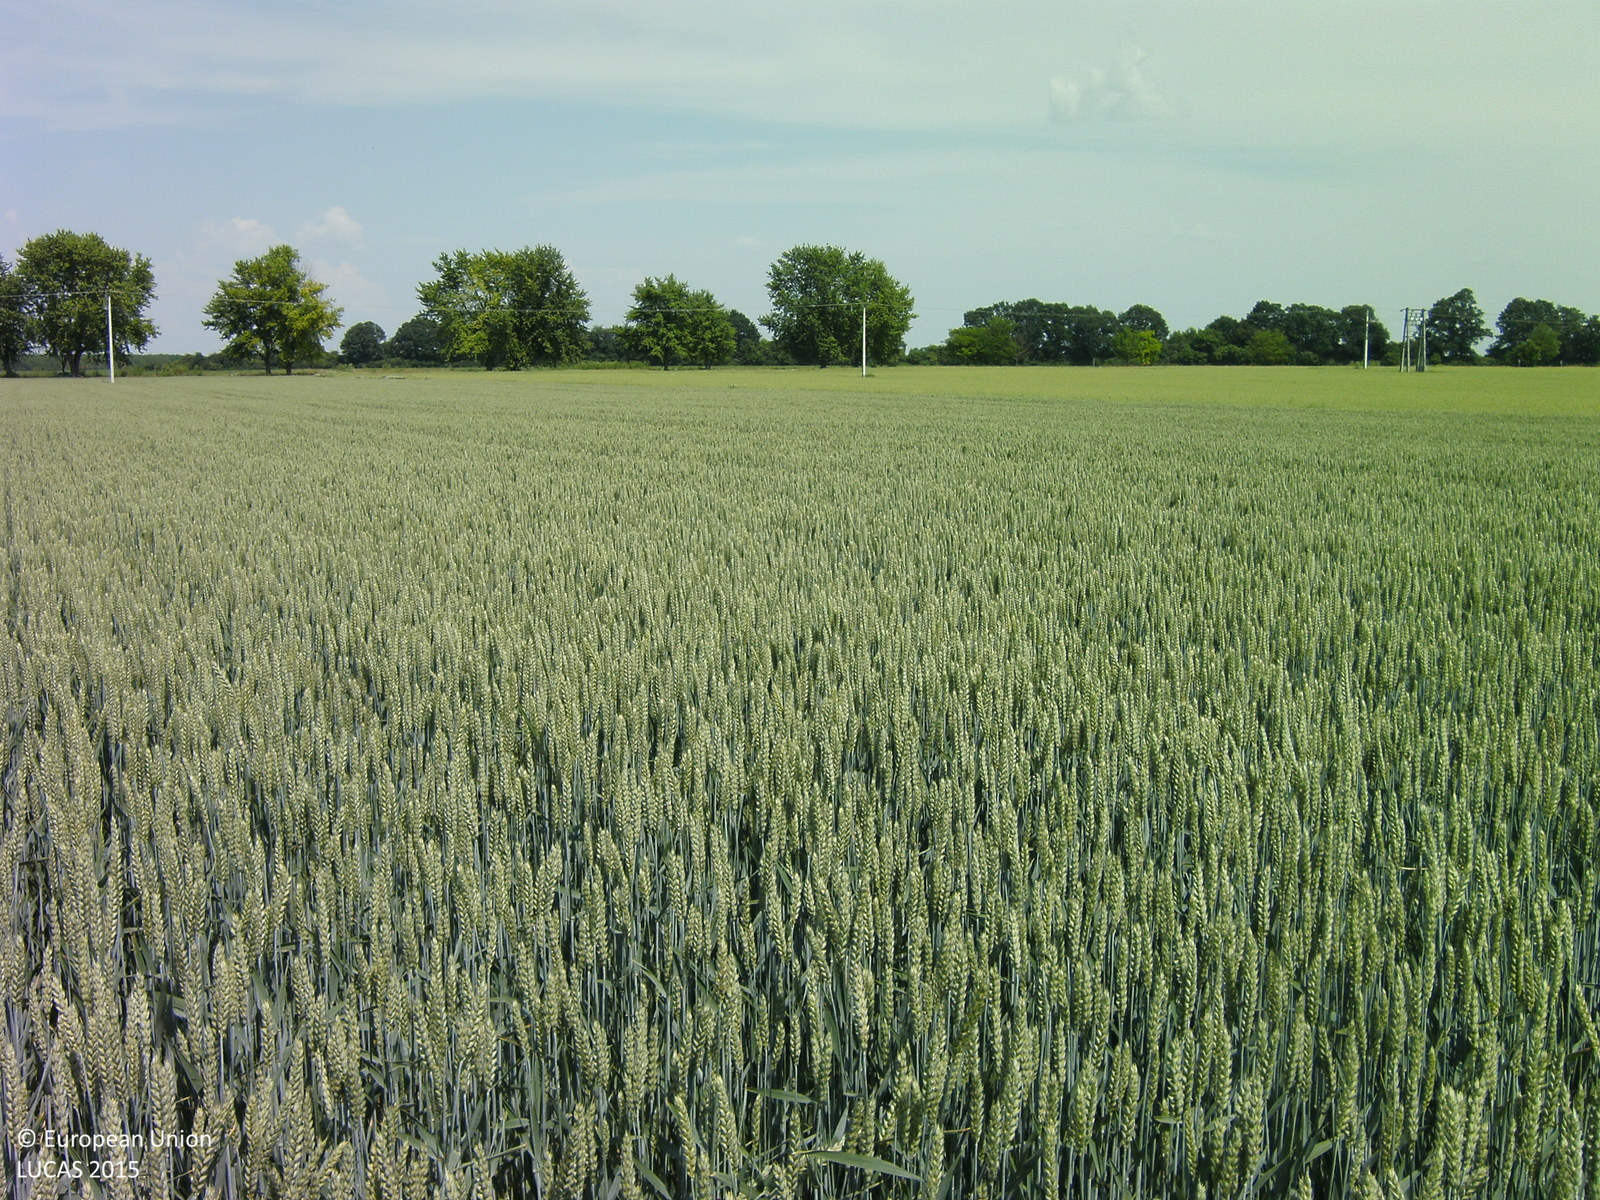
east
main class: Cropland
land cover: Durum wheat
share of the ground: > 75 %
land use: Agriculture (excluding fallow land and kitchen gardens)
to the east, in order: Durum wheat; Rape and turnip rape; Electric lines; Rape and turnip rape
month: June
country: HU
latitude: 46.3958
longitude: 17.7440
